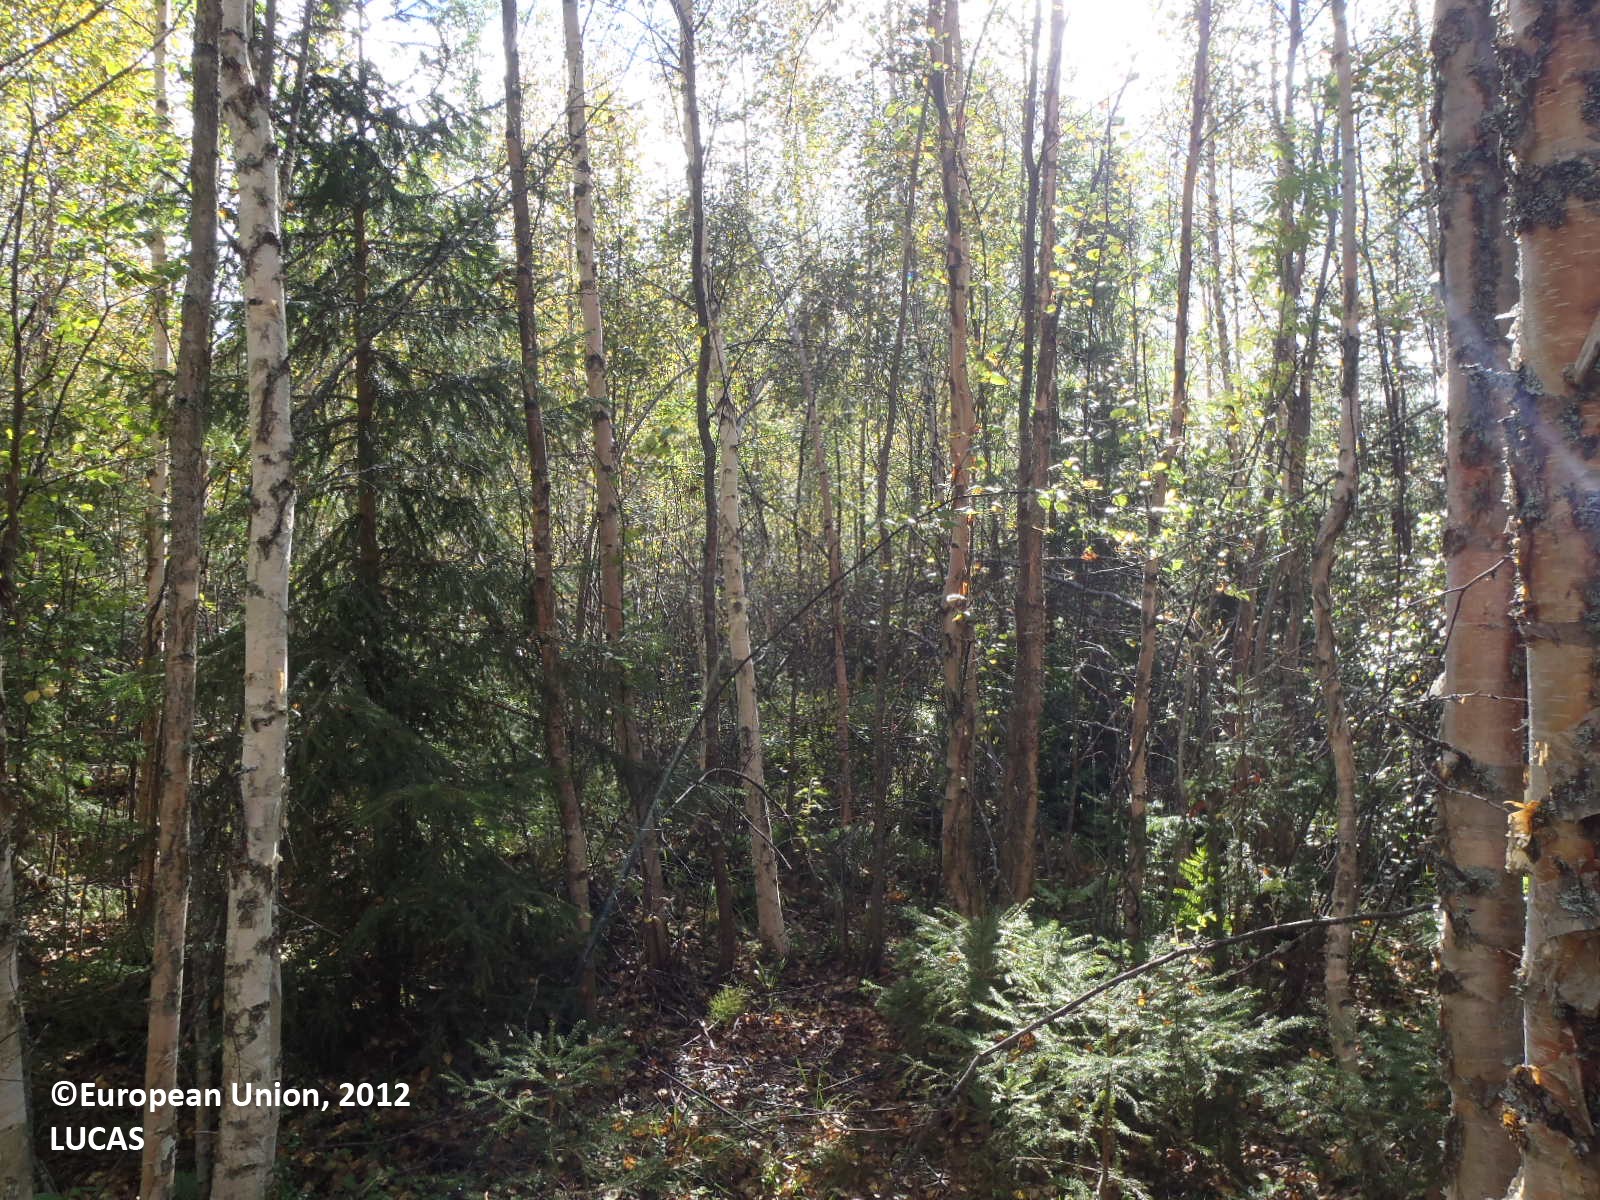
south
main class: Woodland
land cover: Broadleaved woodland
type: boreal forest
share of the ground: > 75 %
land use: Forestry
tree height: > 5 m
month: September
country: FI
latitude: 61.5166
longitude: 22.5641
